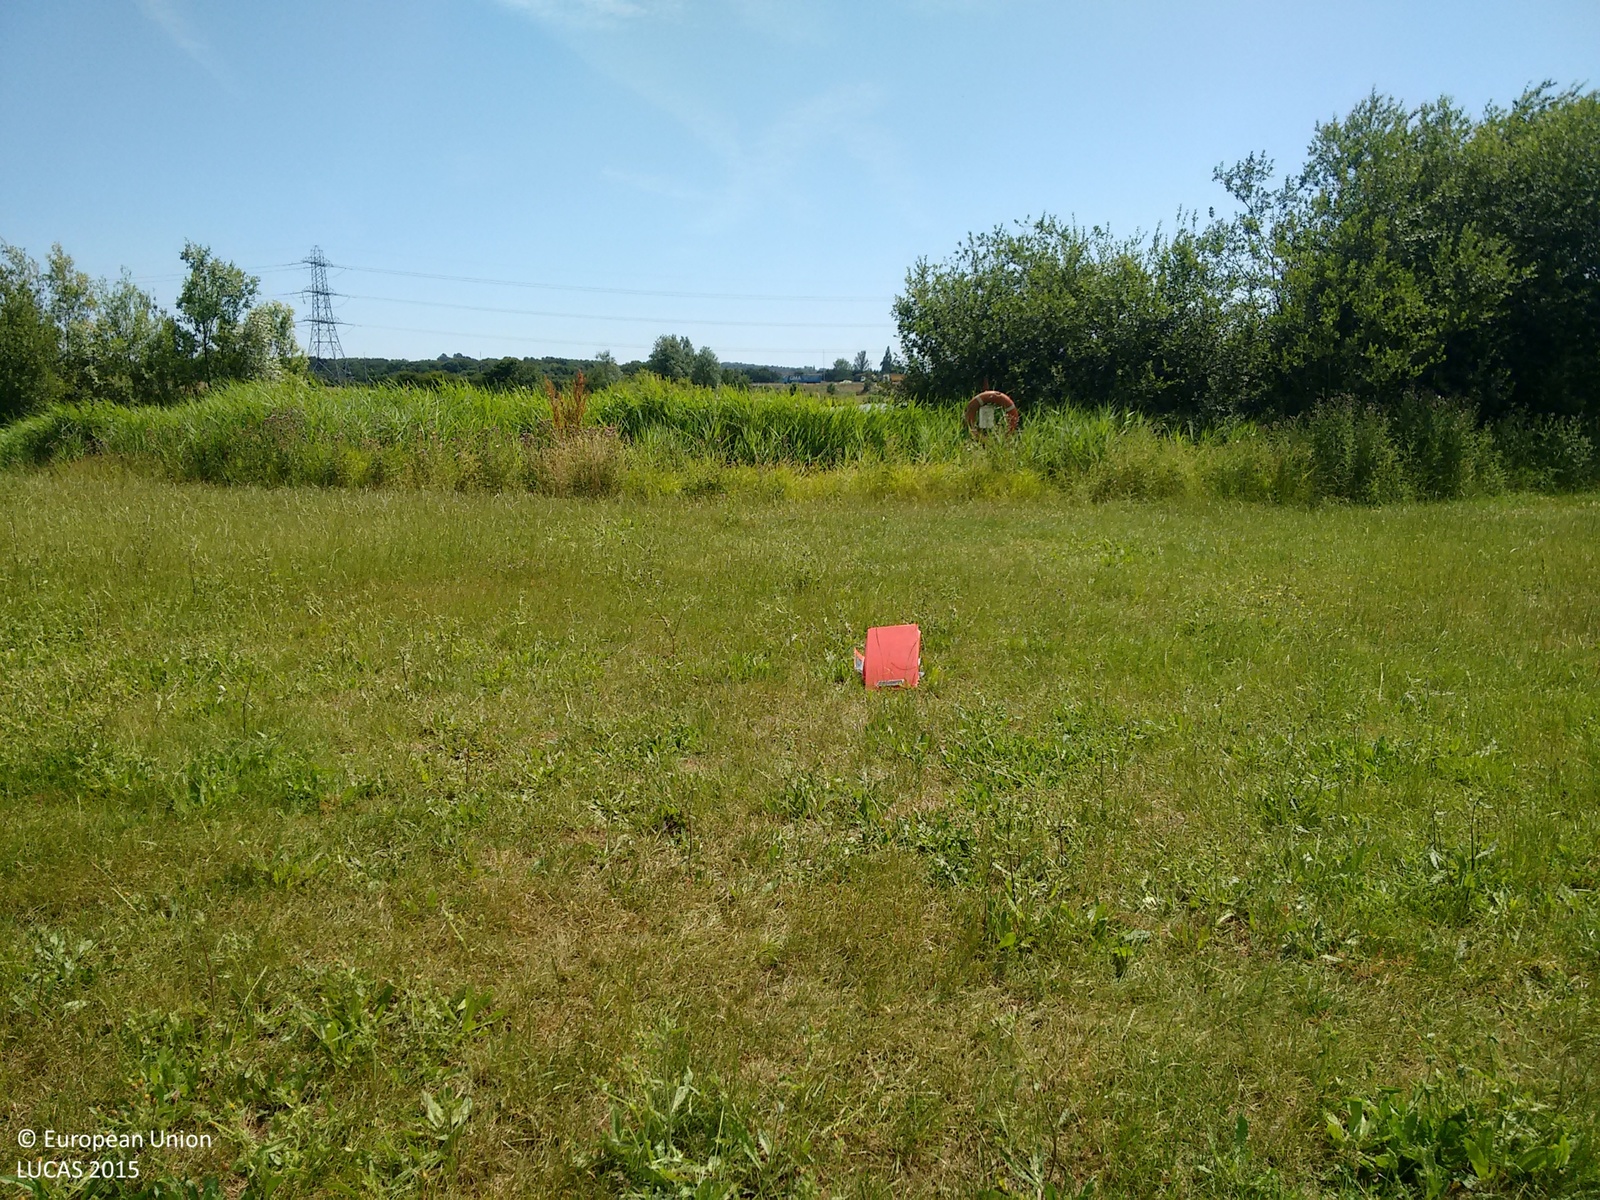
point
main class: Grassland
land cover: Grassland without tree/shrub cover
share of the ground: > 75 %
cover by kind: herbaceous plants 100 %
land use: Sport
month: July
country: GB
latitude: 51.5832
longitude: 0.5486
